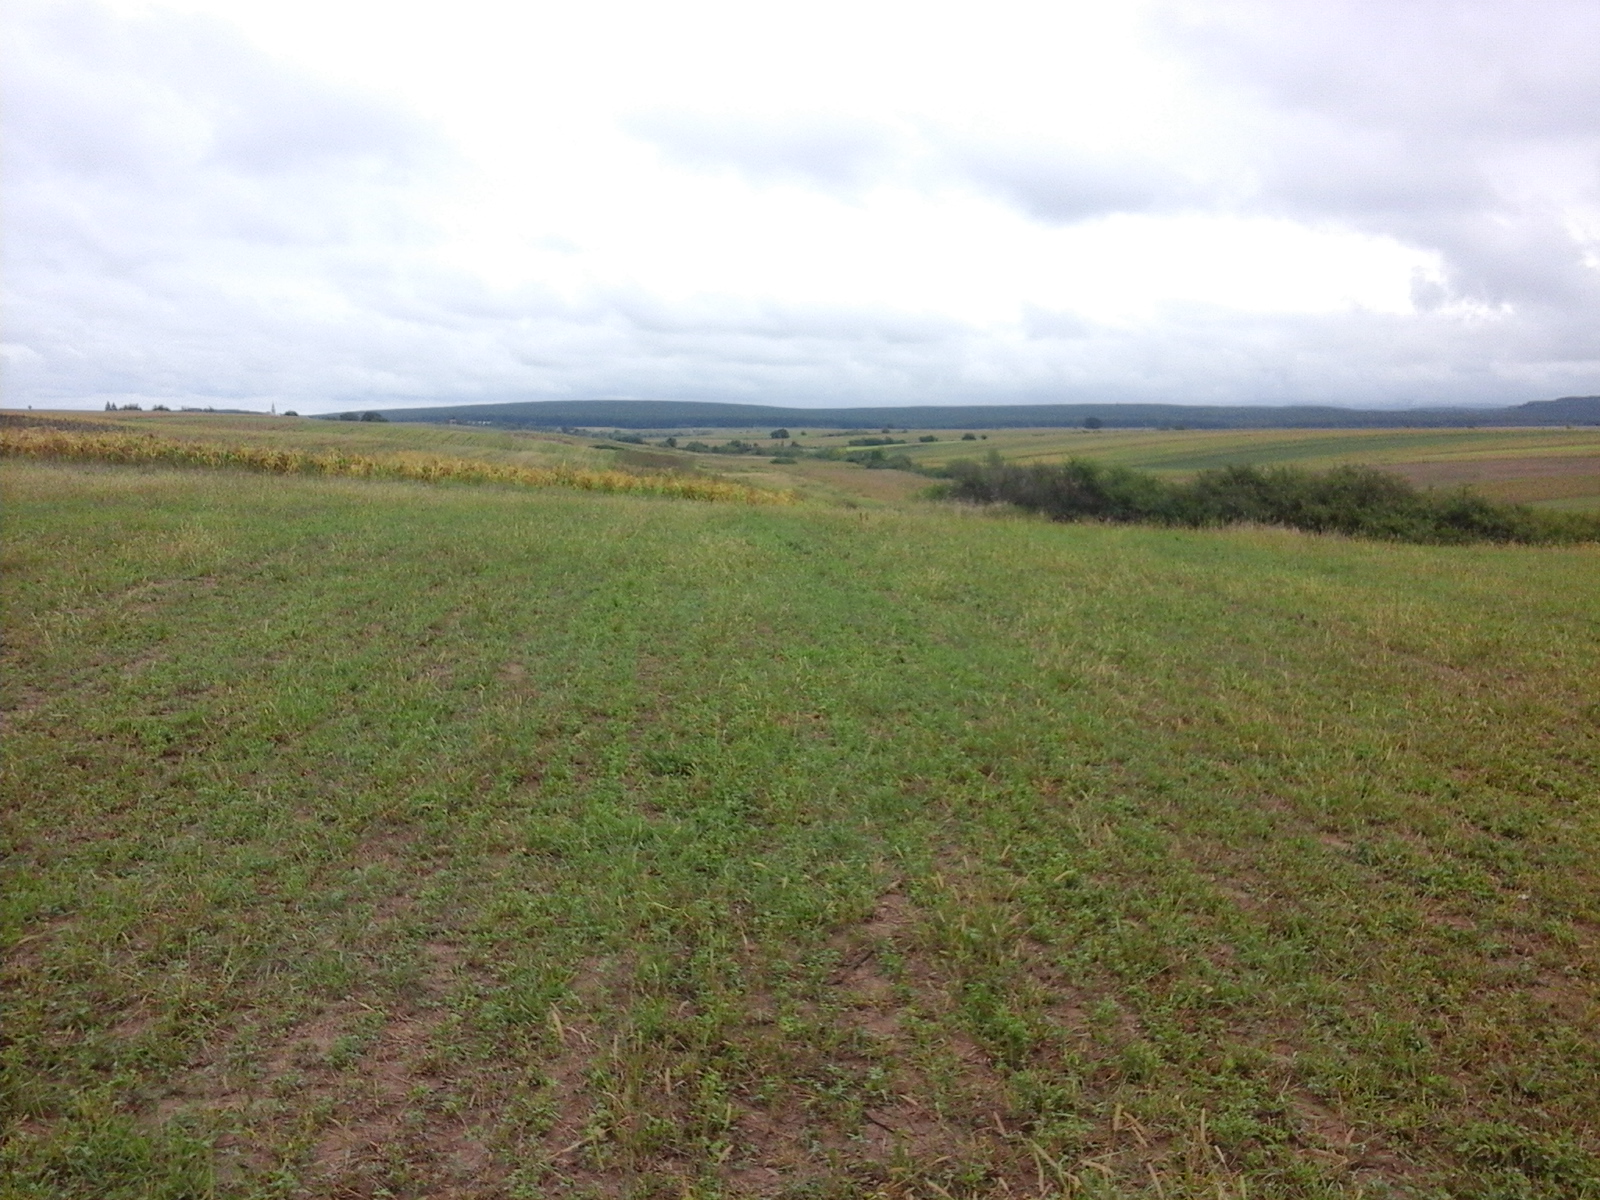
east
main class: Grassland
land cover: Grassland without tree/shrub cover
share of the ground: > 75 %
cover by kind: herbaceous plants 100 %
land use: Agriculture (excluding fallow land and kitchen gardens)
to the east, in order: Grassland without tree/shrub cover; Tracks; Other cereals; Spontaneously vegetated surfaces
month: September
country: RO
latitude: 46.6790
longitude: 21.9543
